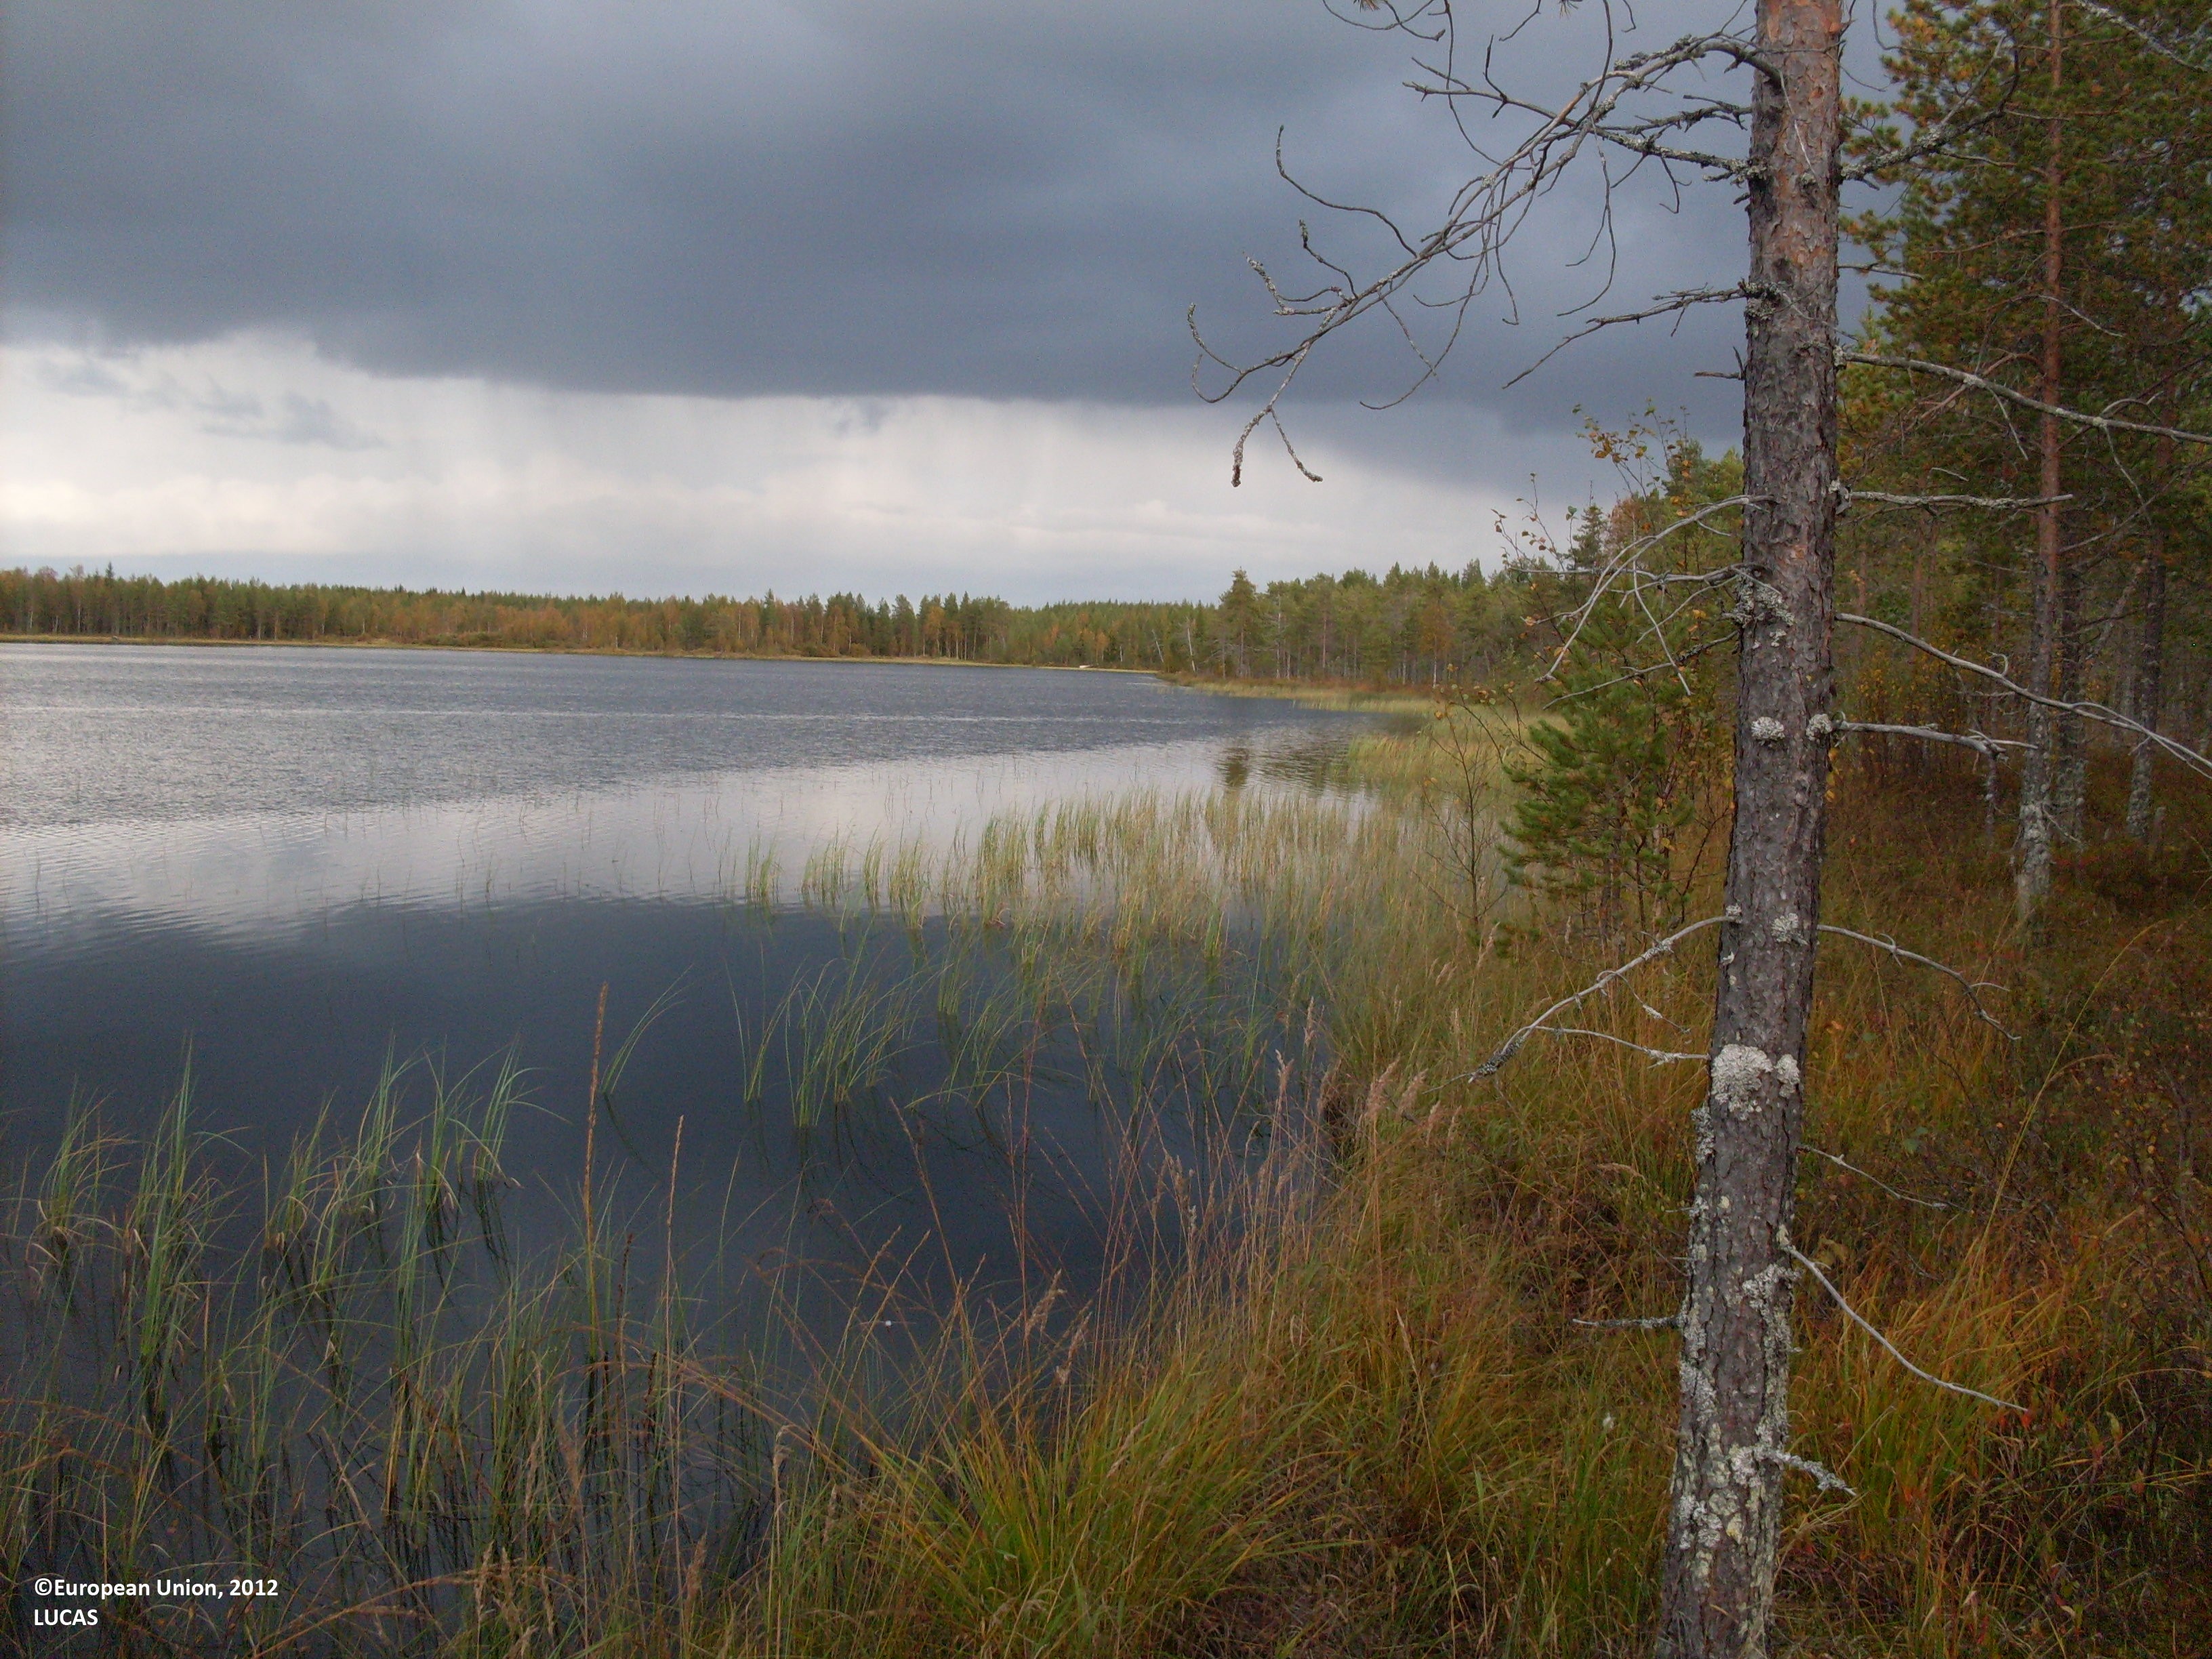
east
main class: Woodland
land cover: Pine dominated mixed woodland
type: boreal forest
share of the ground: 10 - 25 %
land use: Forestry
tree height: > 5 m
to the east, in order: Pine dominated mixed woodland; Spruce dominated coniferous woodland; Inland marshes; Inland water bodies; Inland marshes; Pine dominated mixed woodland
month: September
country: FI
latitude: 64.0355
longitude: 30.0384
